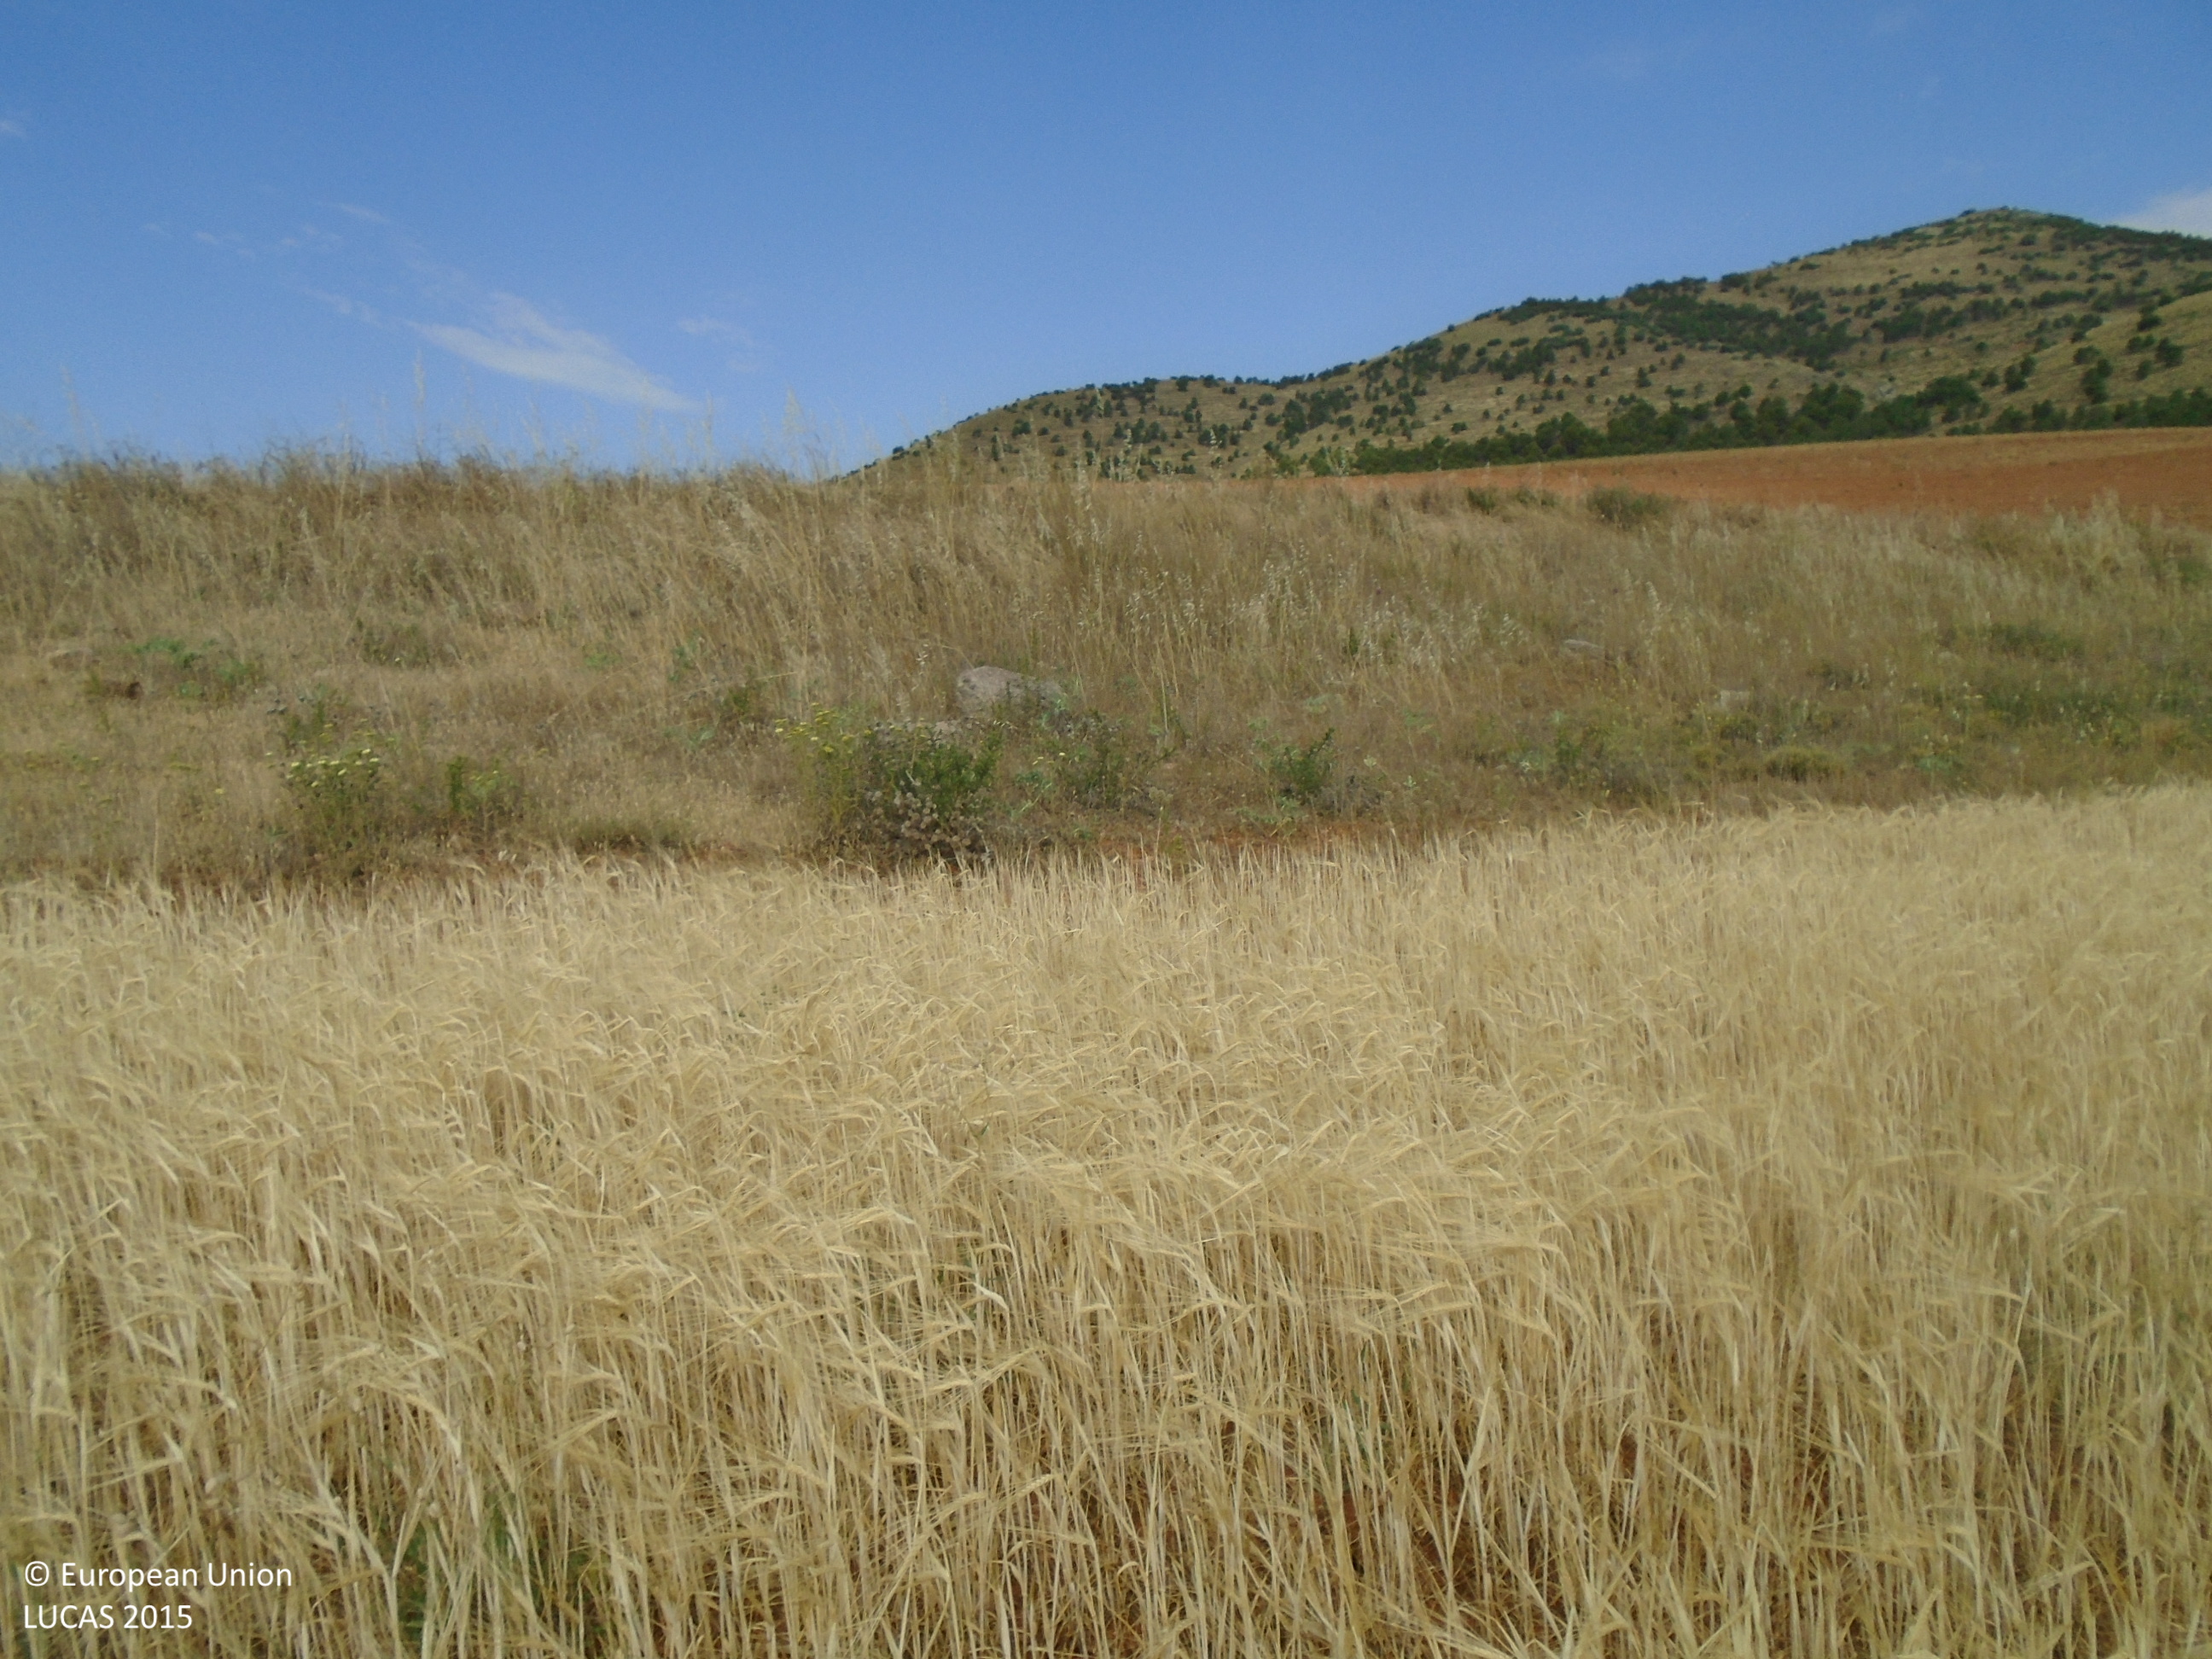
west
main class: Cropland
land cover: Barley
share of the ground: > 75 %
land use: Agriculture (excluding fallow land and kitchen gardens)
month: June
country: ES
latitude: 39.7436
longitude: -4.1904
